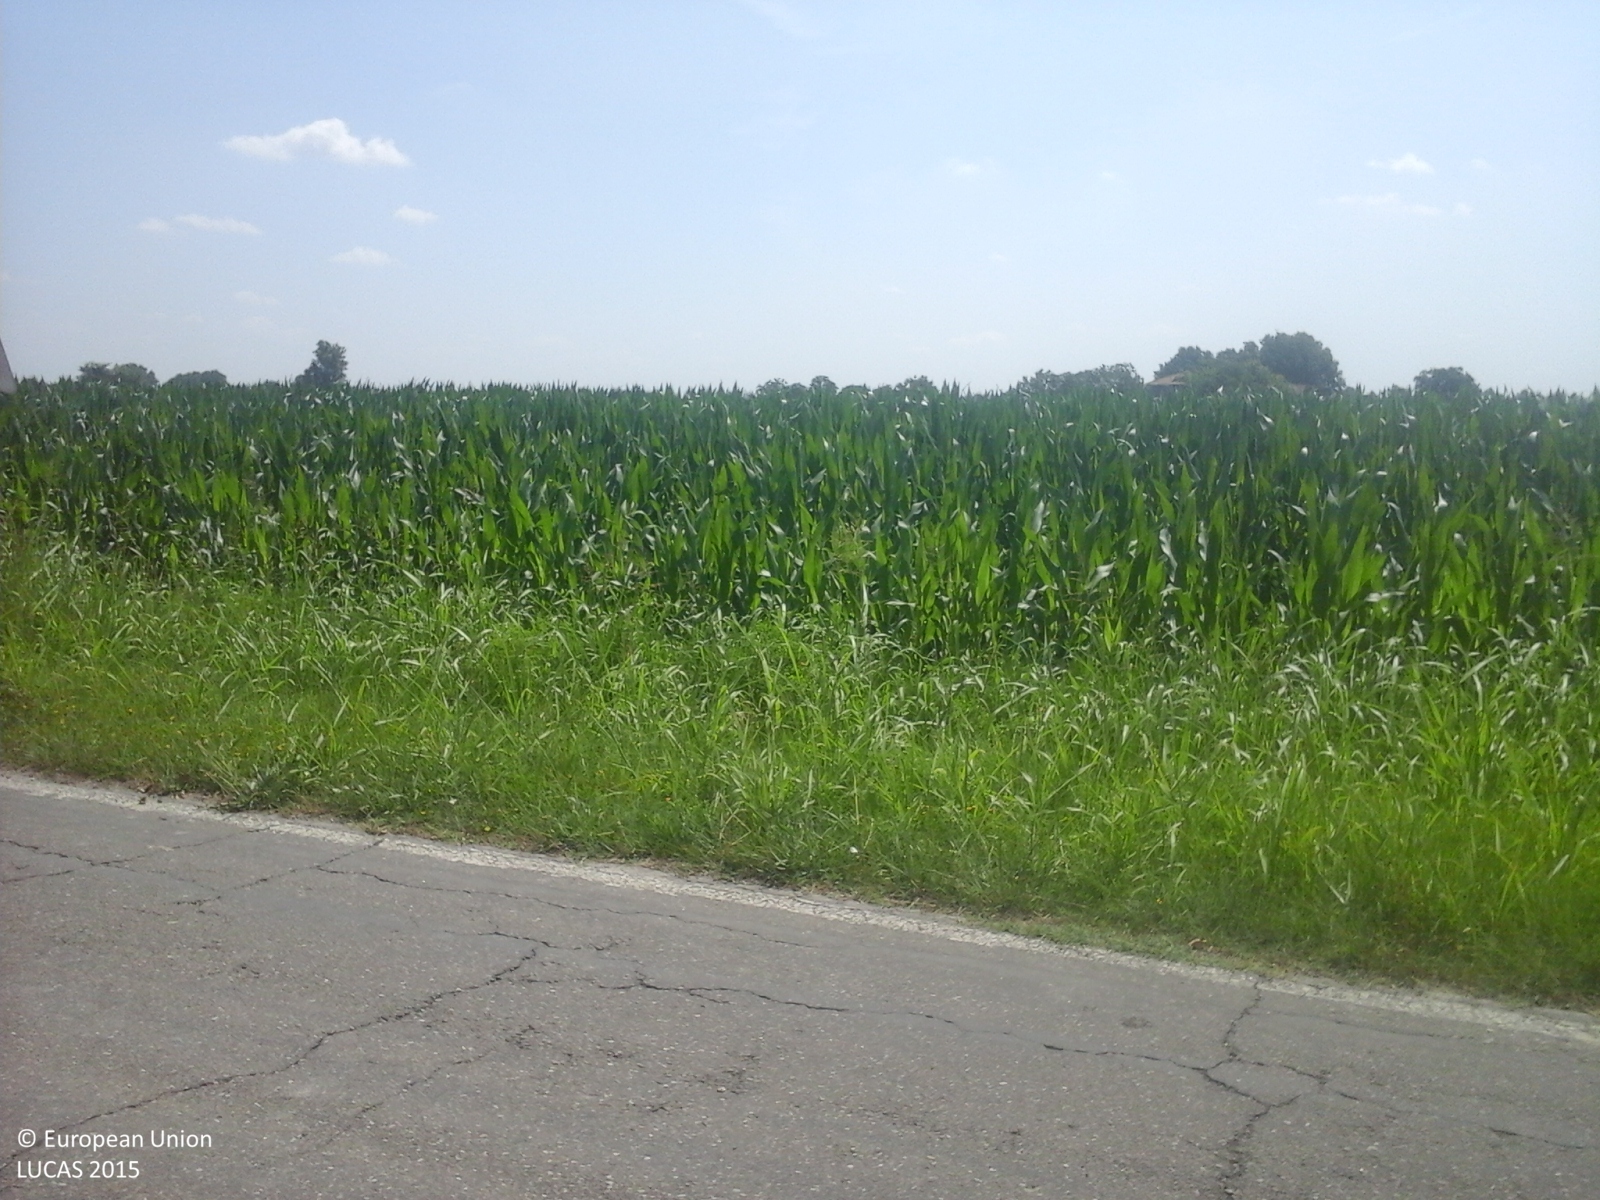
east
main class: Cropland
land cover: Maize
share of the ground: > 75 %
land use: Agriculture (excluding fallow land and kitchen gardens)
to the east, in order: Maize; Ditches and canals; Maize; Grass margins; Ditches and canals; Grass margins; Paved roads, cycling and walking lanes; Grass margins; Ditches and canals; Grass margins; Maize; Ditches and canals; Maize; Ditches and canals; Maize; Pear fruit
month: June
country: IT
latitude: 44.8329
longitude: 10.9720
